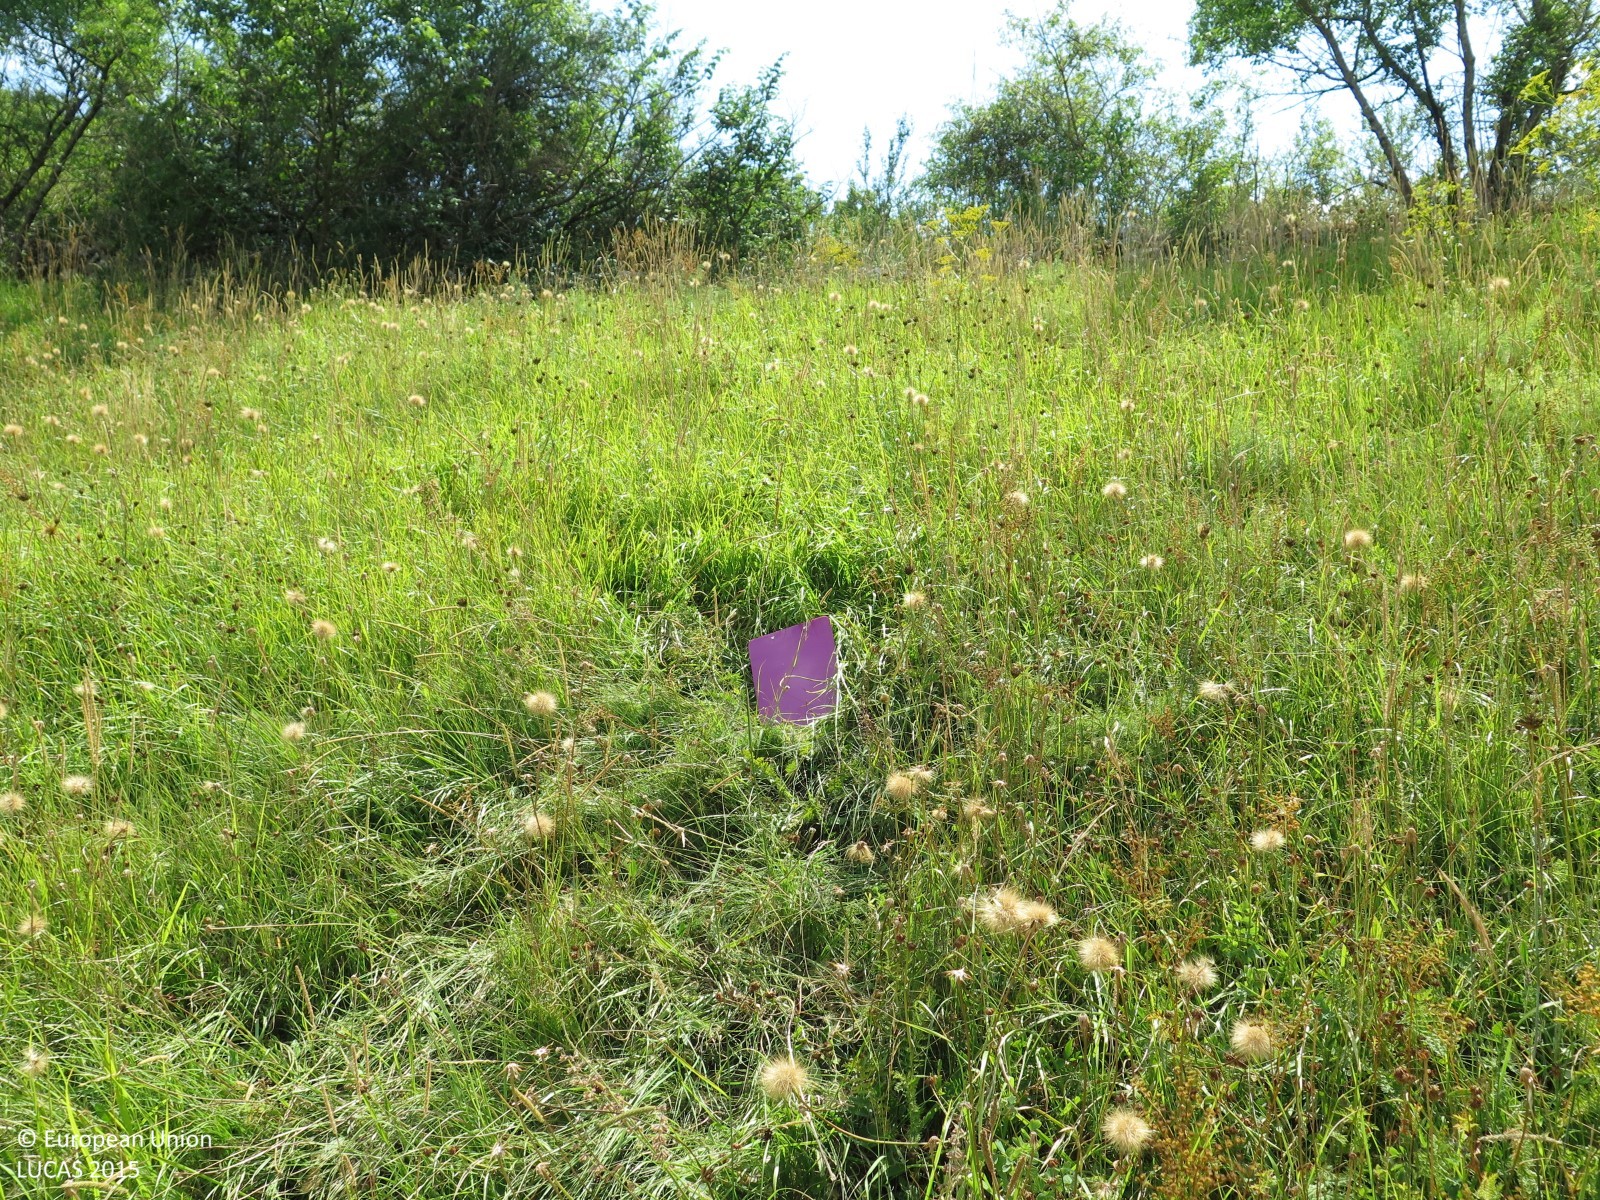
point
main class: Grassland
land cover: Grassland without tree/shrub cover
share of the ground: > 75 %
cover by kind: herbaceous plants 100 %
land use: Abandoned areas
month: June
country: HR
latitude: 45.1540
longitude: 14.1031
